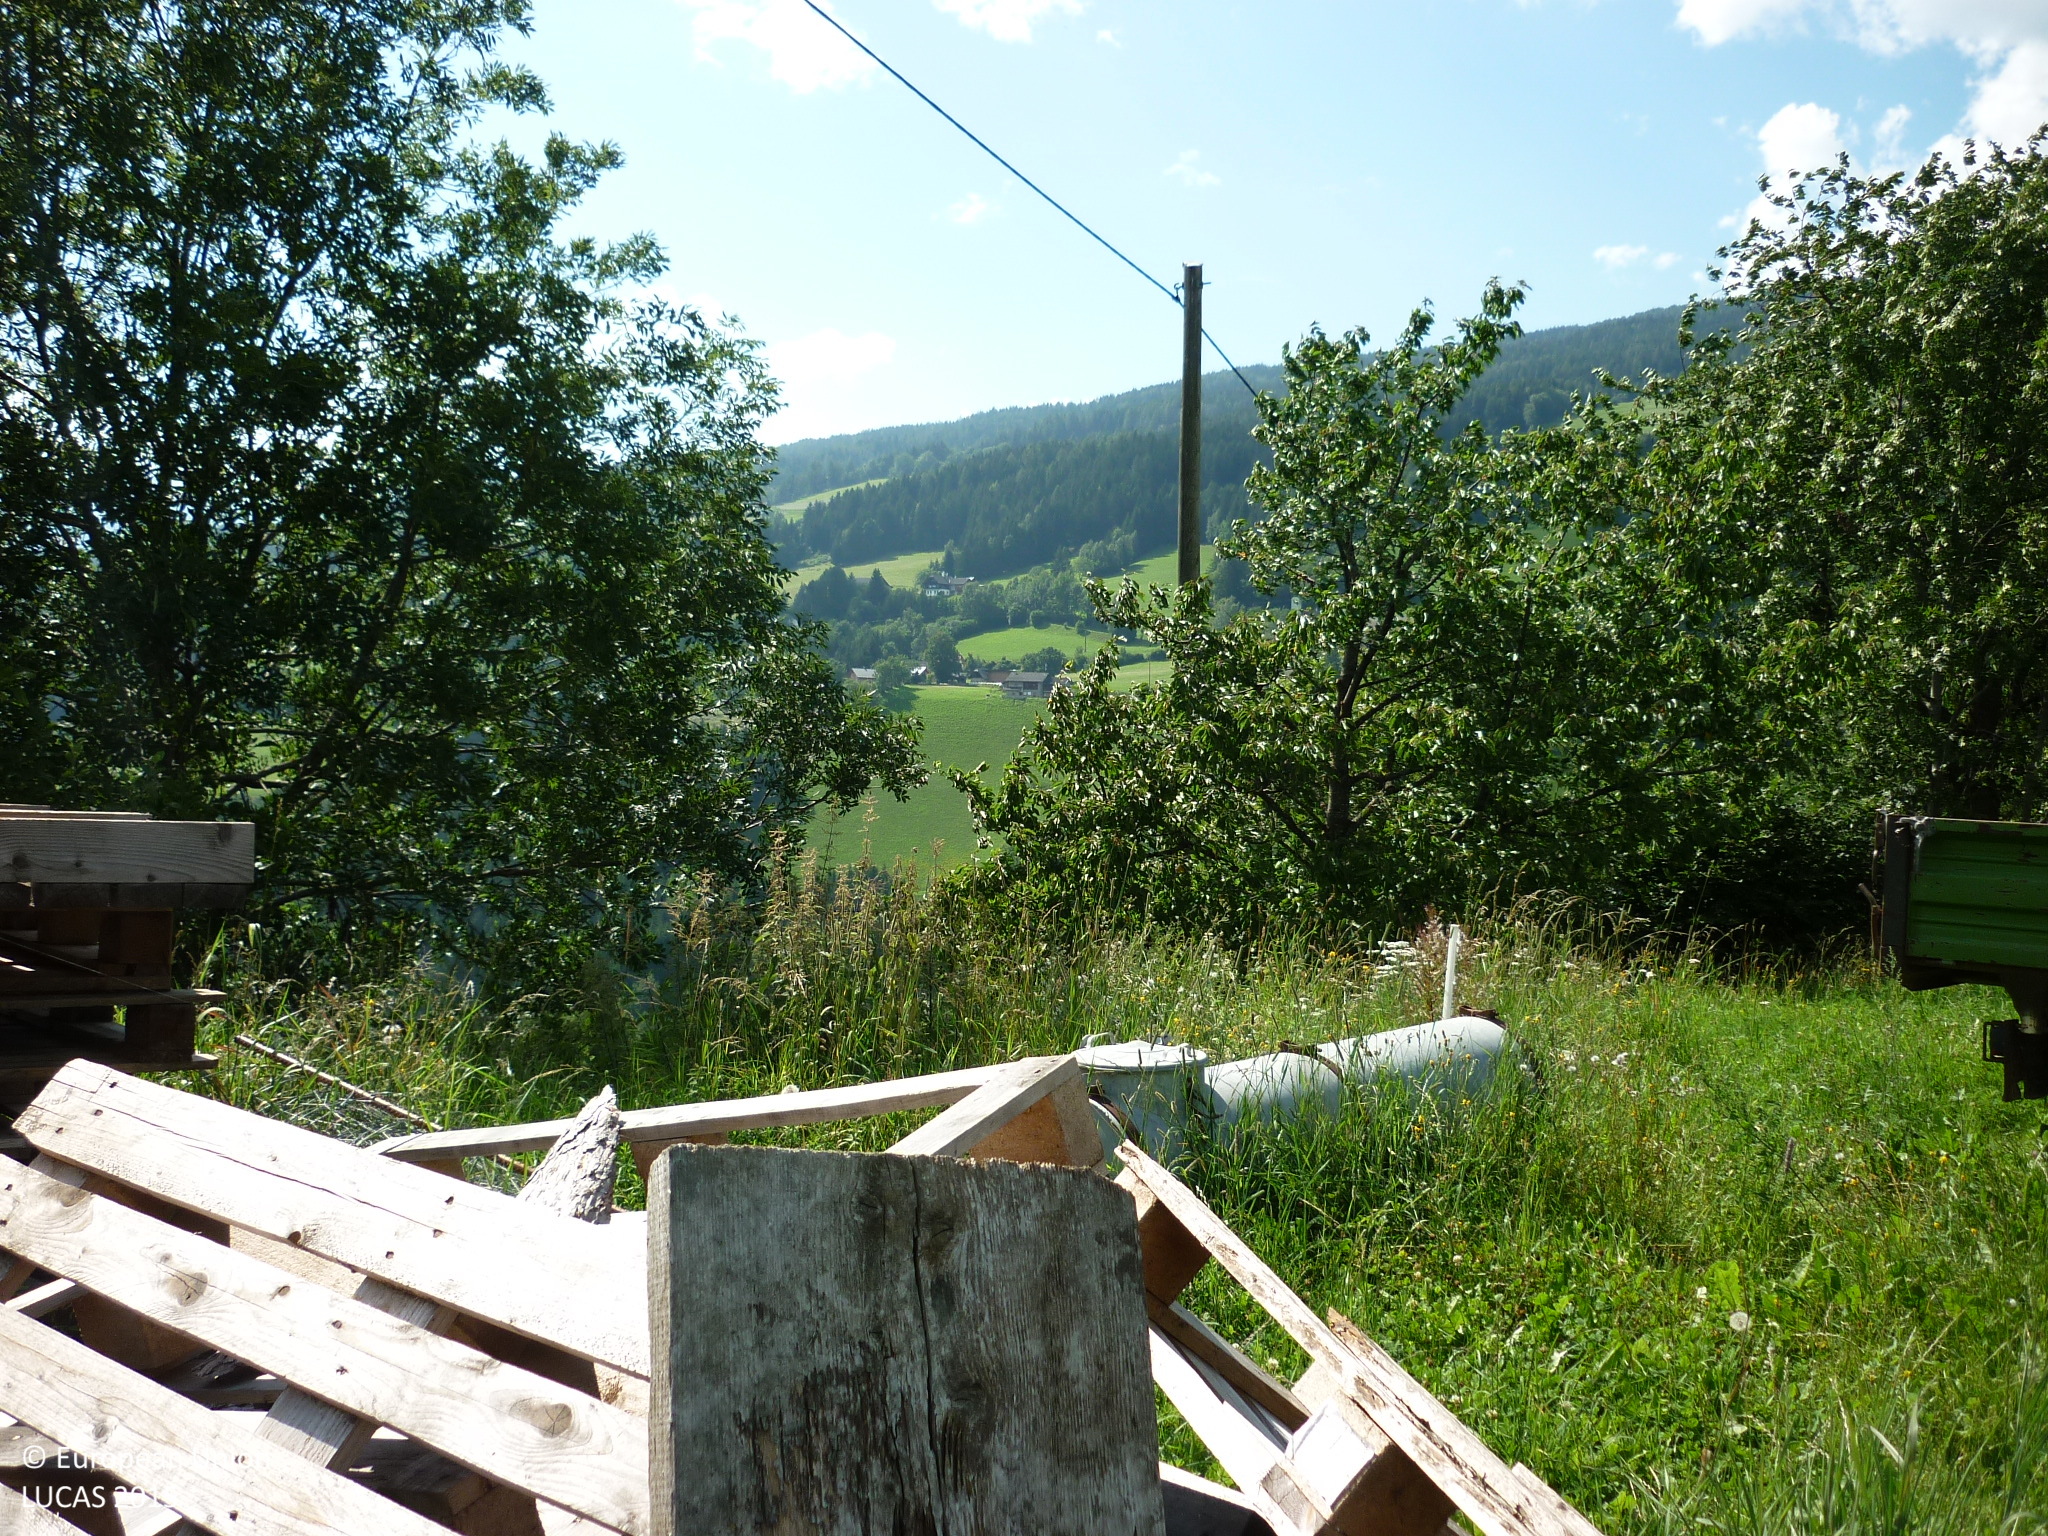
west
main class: Grassland
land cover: Grassland without tree/shrub cover
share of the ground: > 75 %
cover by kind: herbaceous plants 95 %, unconsolidated bare surface 5 %
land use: Residential
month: August
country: AT
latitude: 46.9393
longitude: 13.6101
